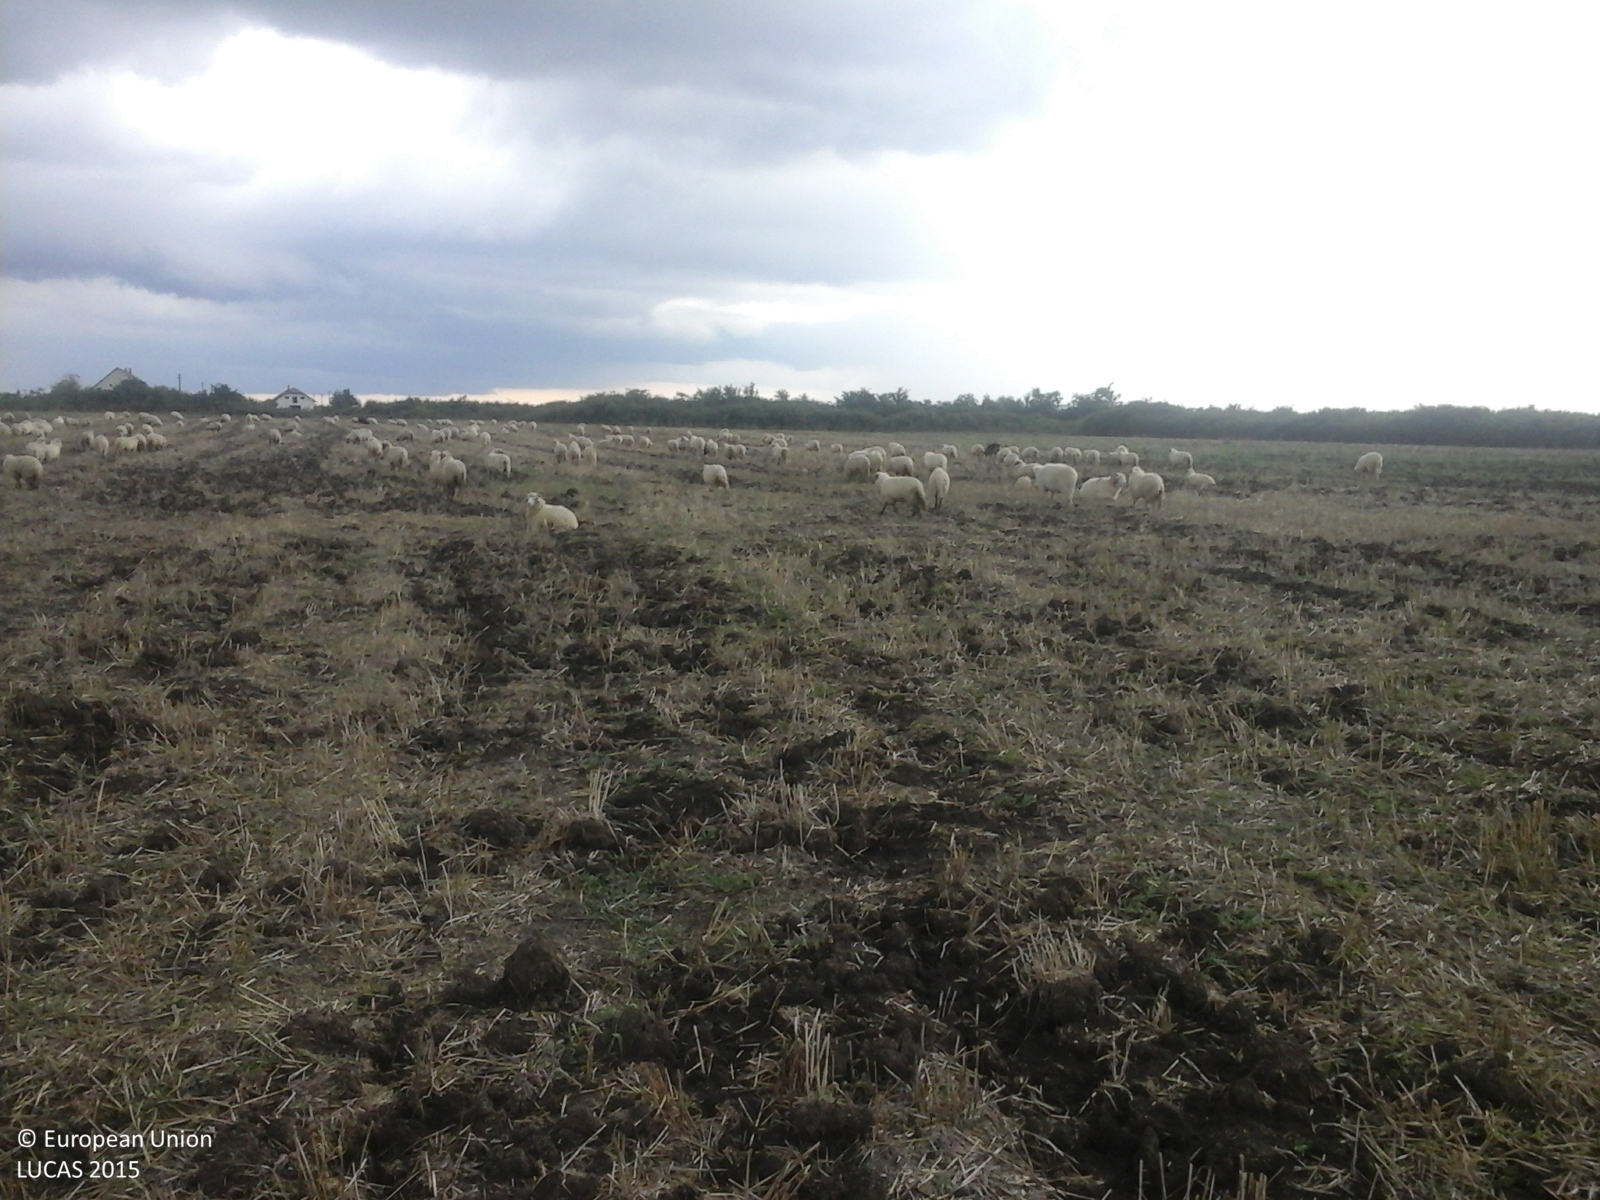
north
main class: Cropland
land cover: Oats
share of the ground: 10 - 25 %
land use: Agriculture (excluding fallow land and kitchen gardens)
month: August
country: RO
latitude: 45.4814
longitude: 21.0939
